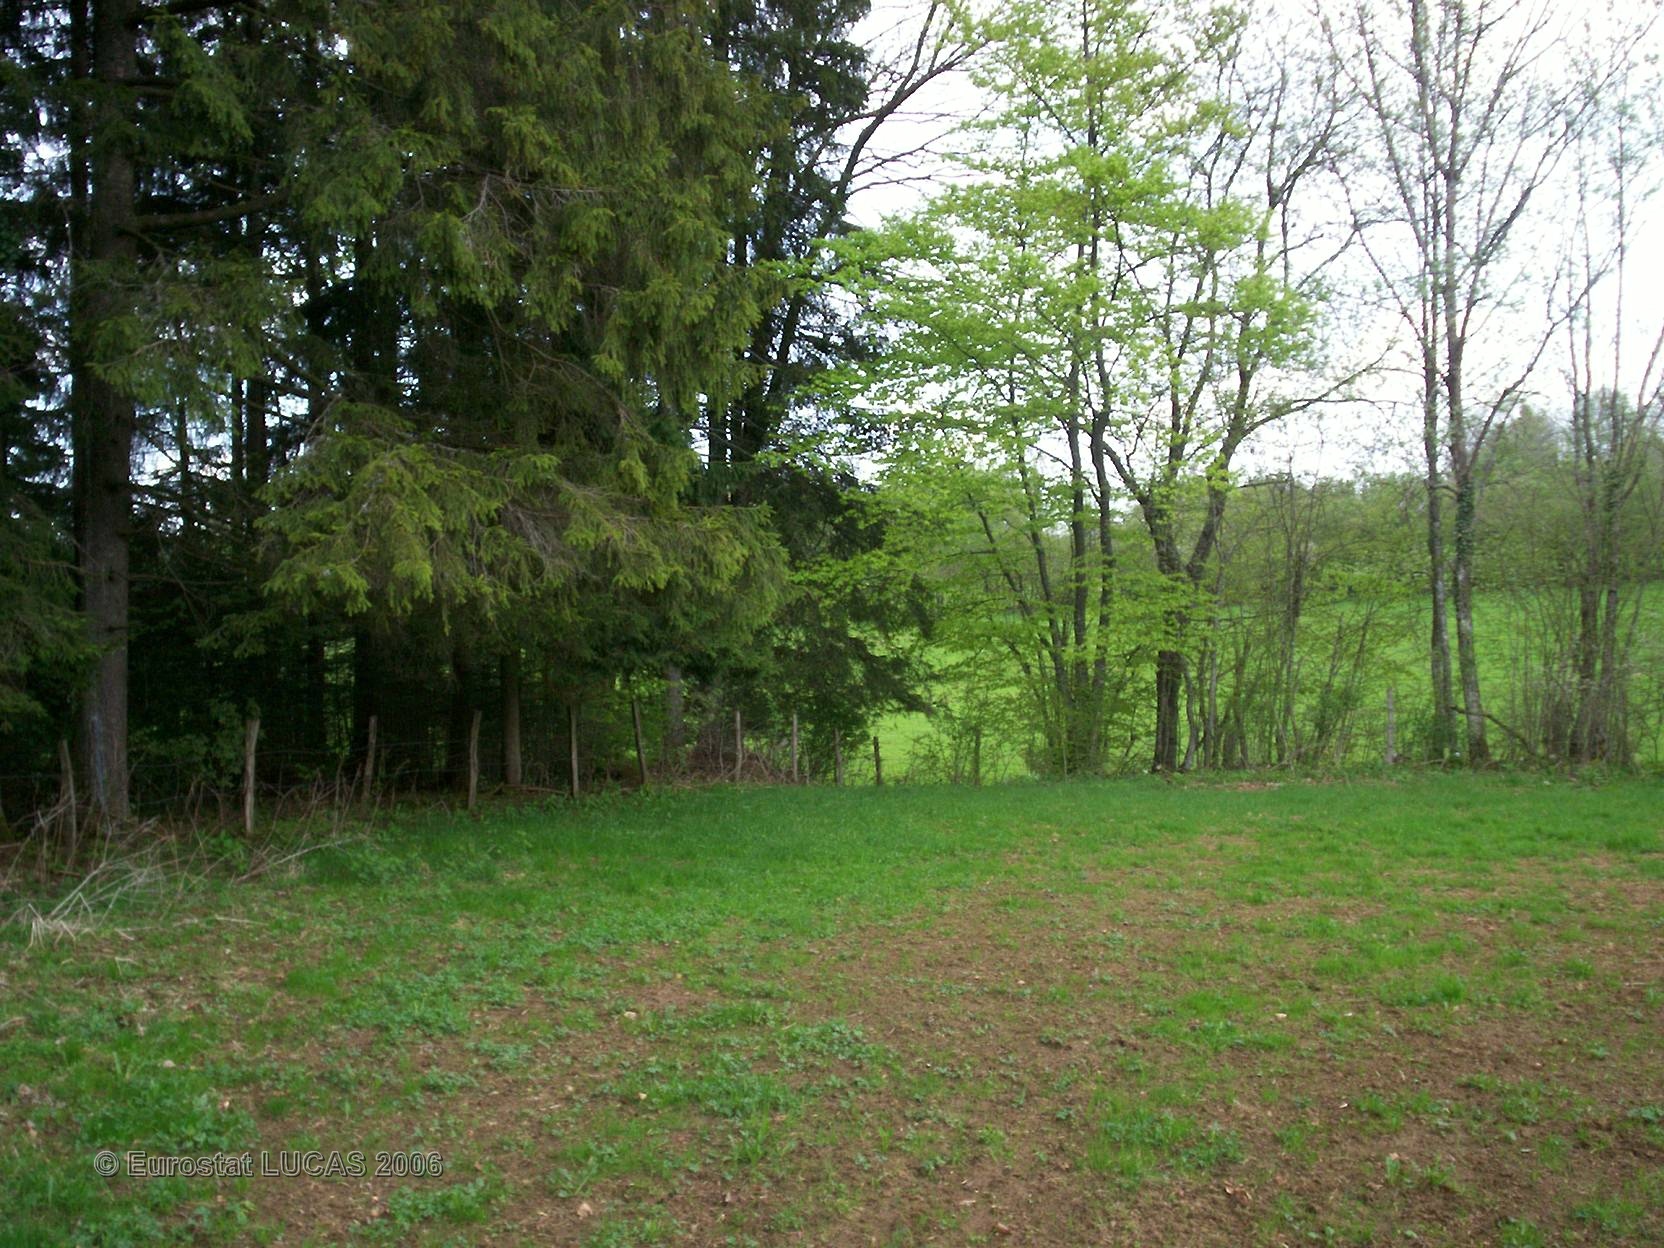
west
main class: Grassland
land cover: Grassland without tree/shrub cover
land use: Agriculture (excluding fallow land and kitchen gardens)
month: May
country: FR
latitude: 47.1455
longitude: 6.6395
